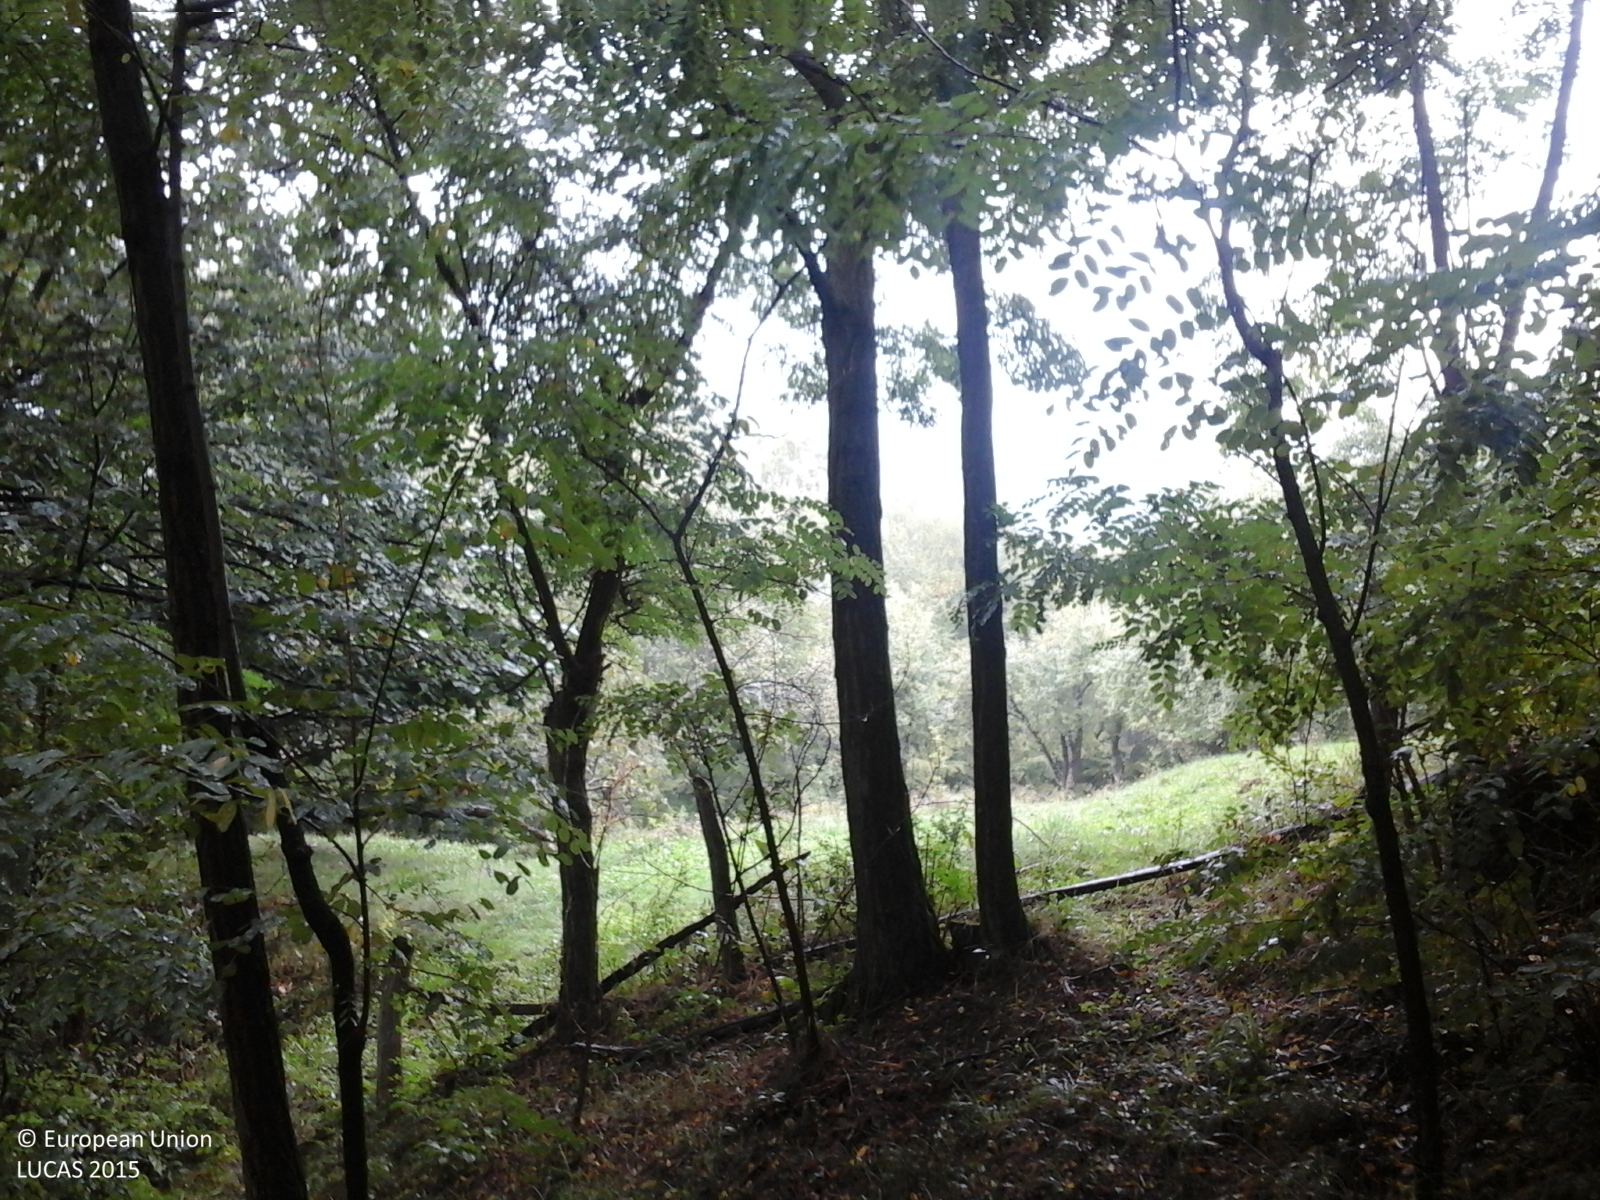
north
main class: Woodland
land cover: Broadleaved woodland
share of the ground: > 75 %
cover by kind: broadleaved forest trees 100 %
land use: Forestry
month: September
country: RO
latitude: 45.1571
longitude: 24.4890
